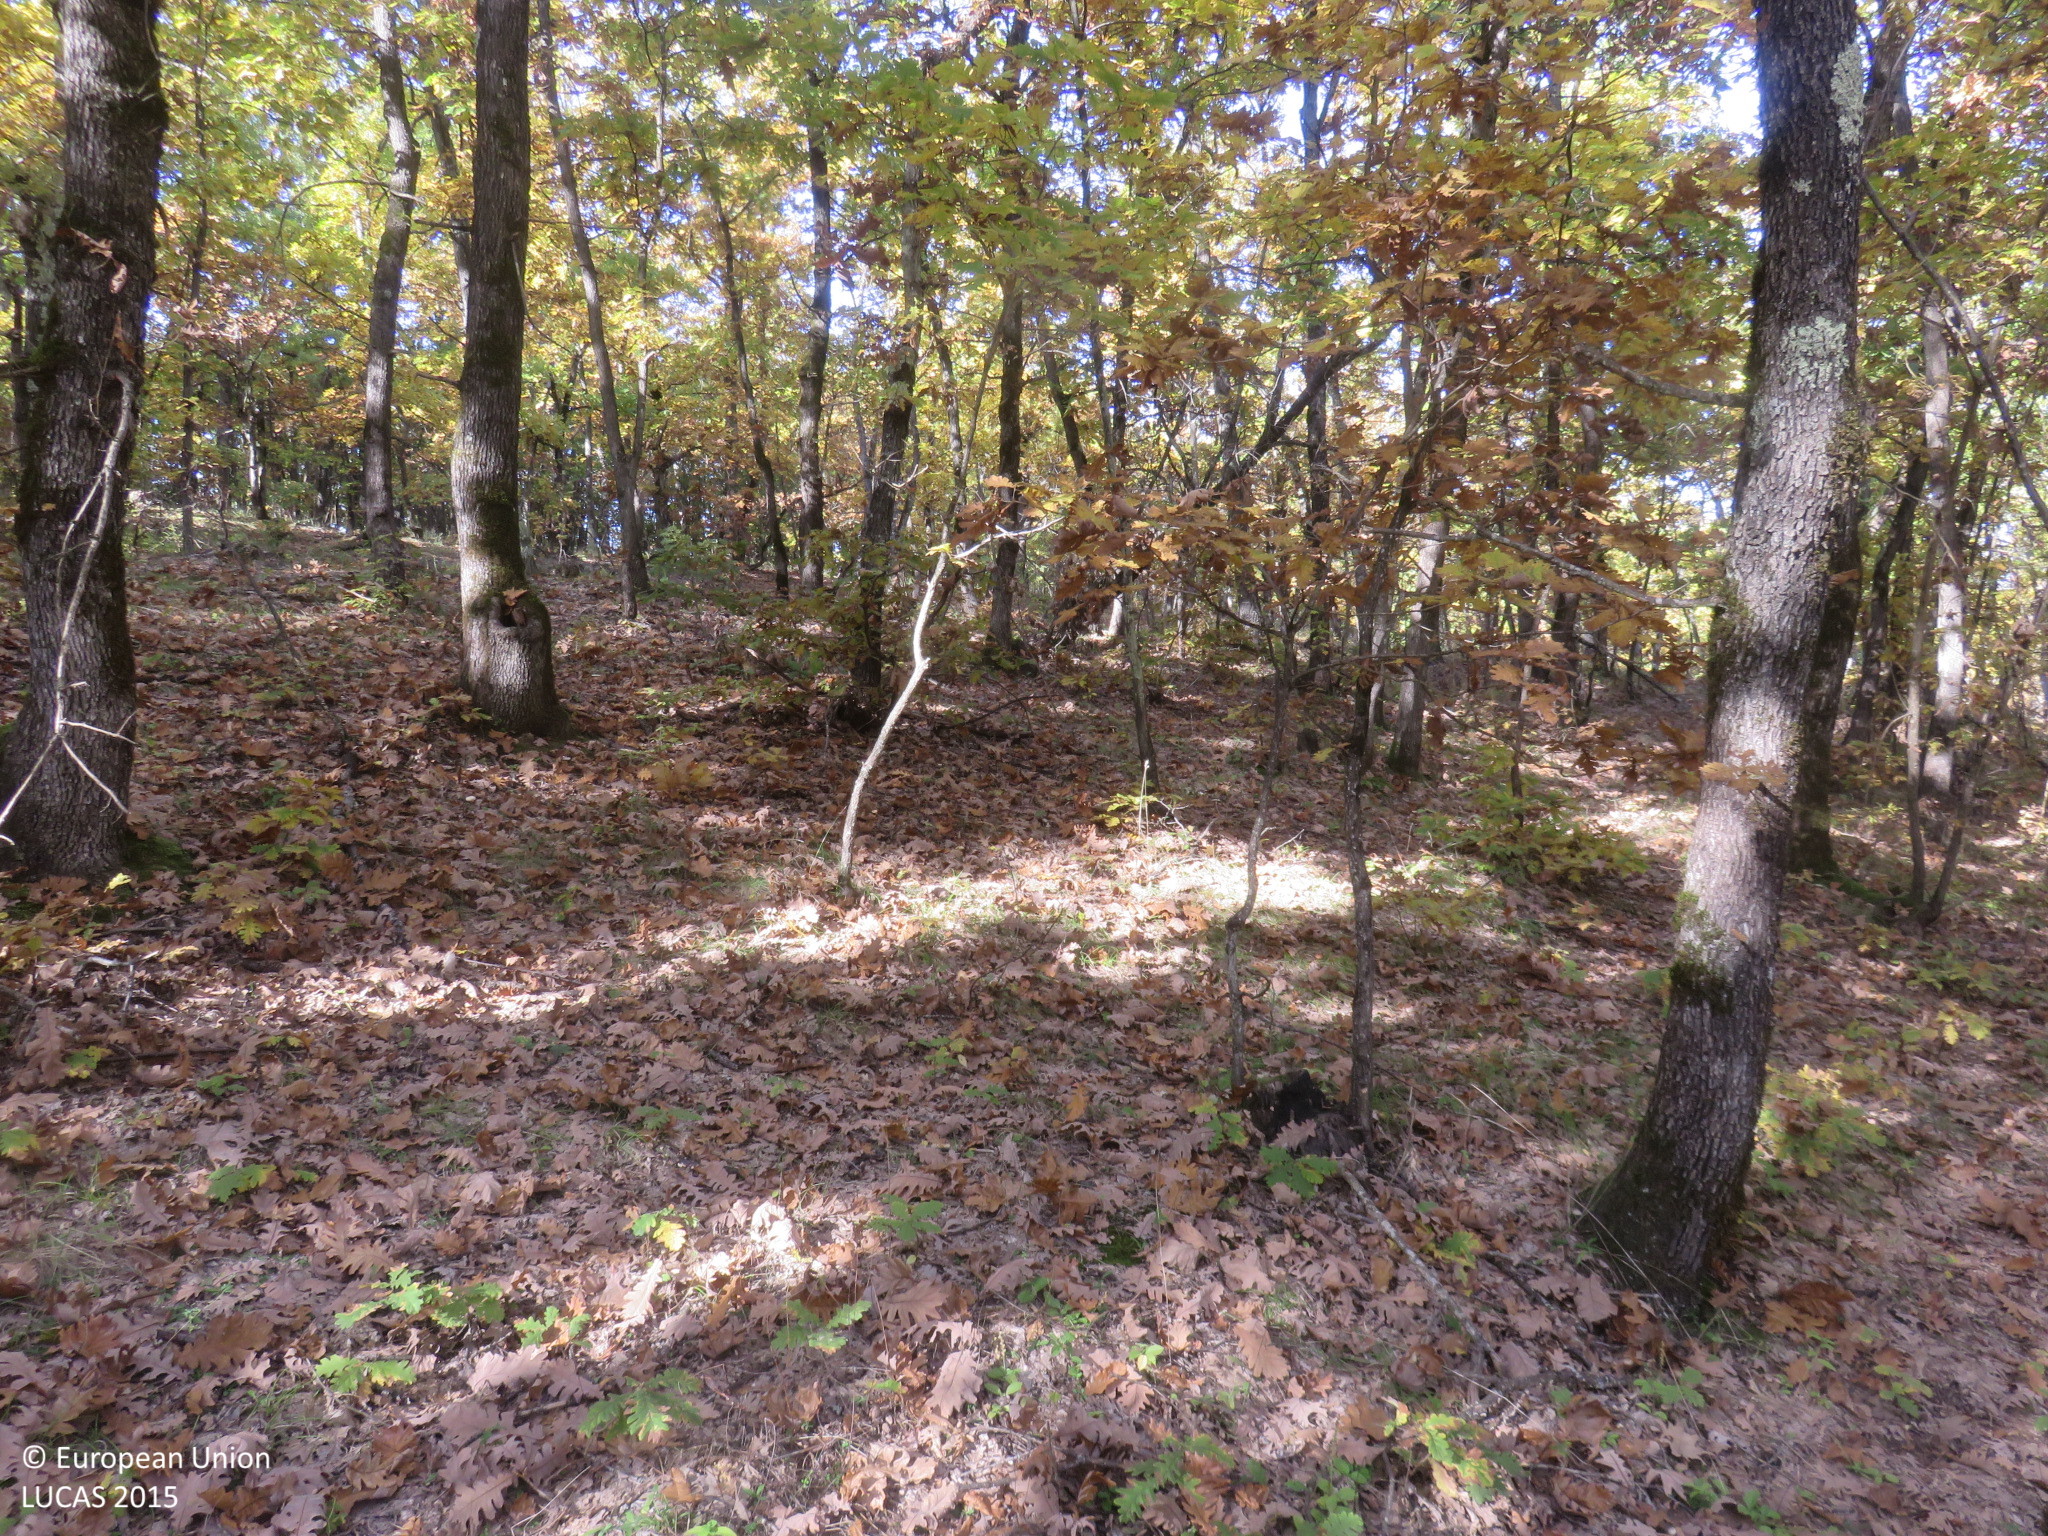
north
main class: Woodland
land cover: Broadleaved woodland
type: mesophytic deciduous forest
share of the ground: > 75 %
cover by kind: broadleaved forest trees 90 %, coniferous forest trees 10 %
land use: Forestry
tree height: > 5 m
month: October
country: BG
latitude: 42.9552
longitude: 24.7828
